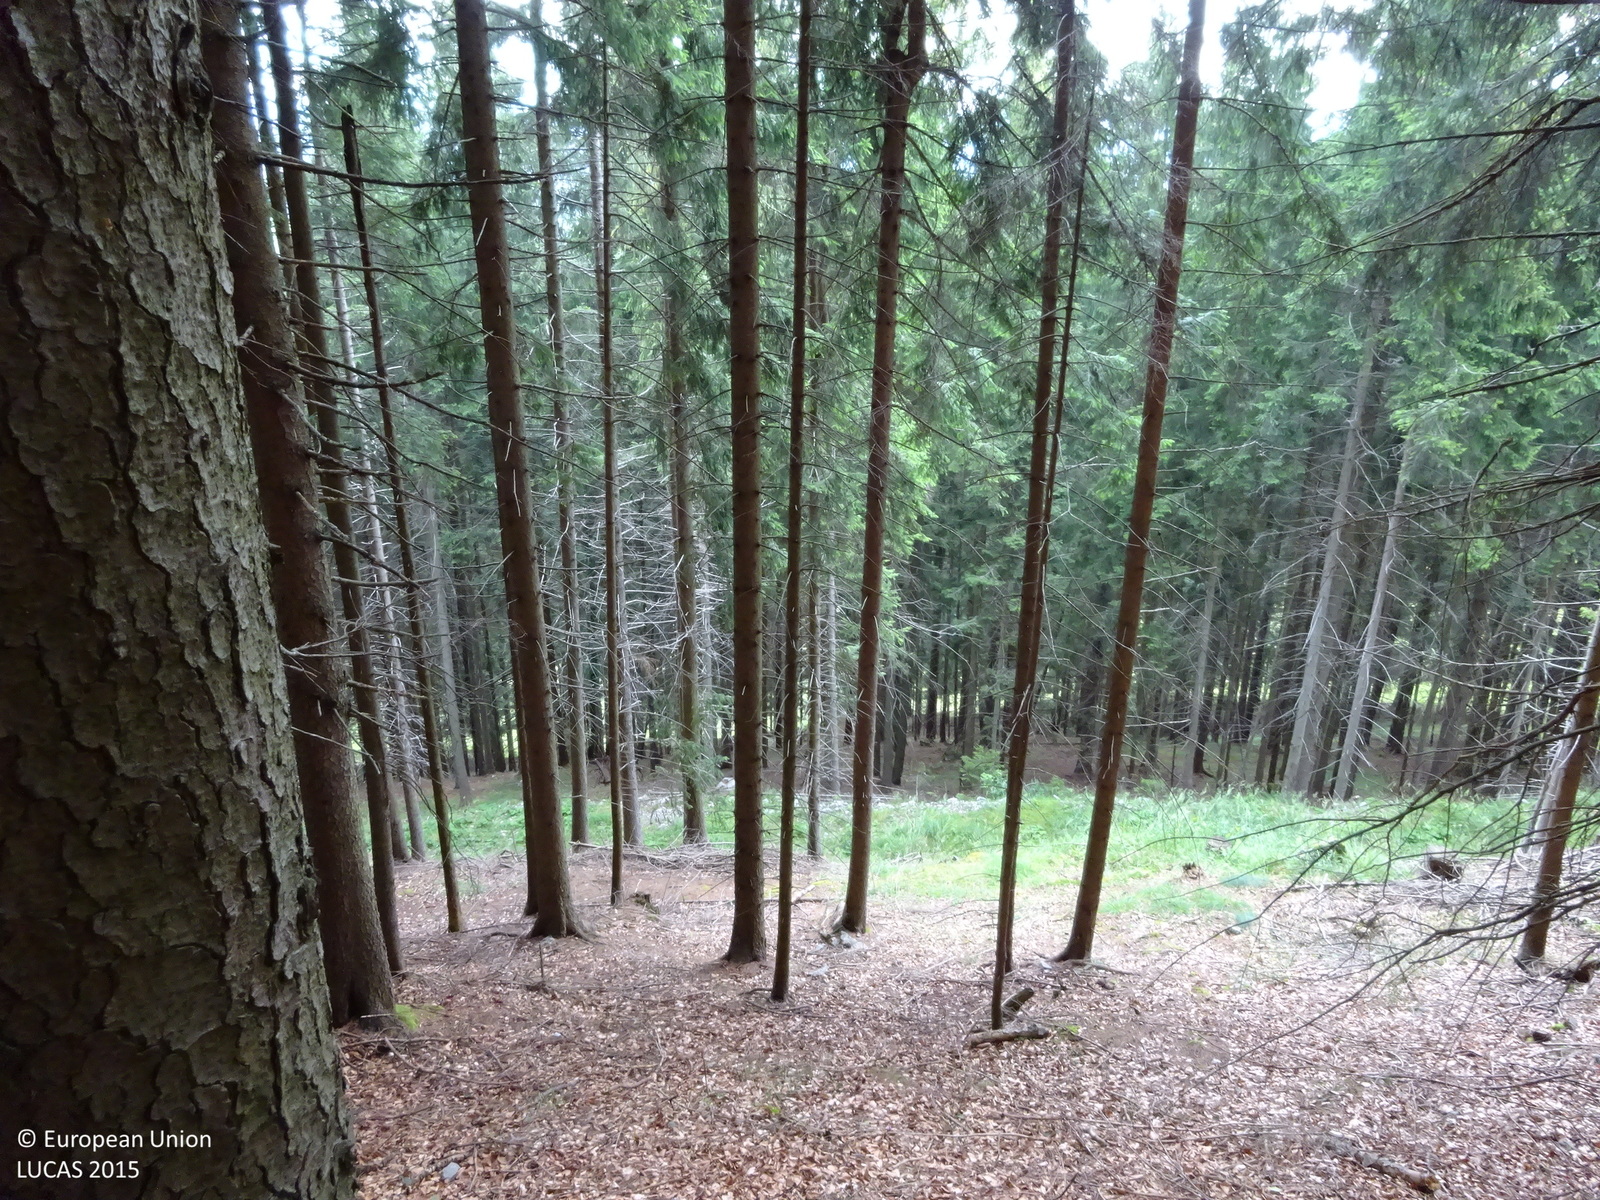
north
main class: Woodland
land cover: Spruce dominated mixed woodland
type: mountainous beech forest
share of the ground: > 75 %
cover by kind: broadleaved forest trees 55 %, coniferous forest trees 35 %, unconsolidated bare surface 10 %
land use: Forestry
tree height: > 5 m
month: July
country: AT
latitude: 47.2047
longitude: 15.4524
